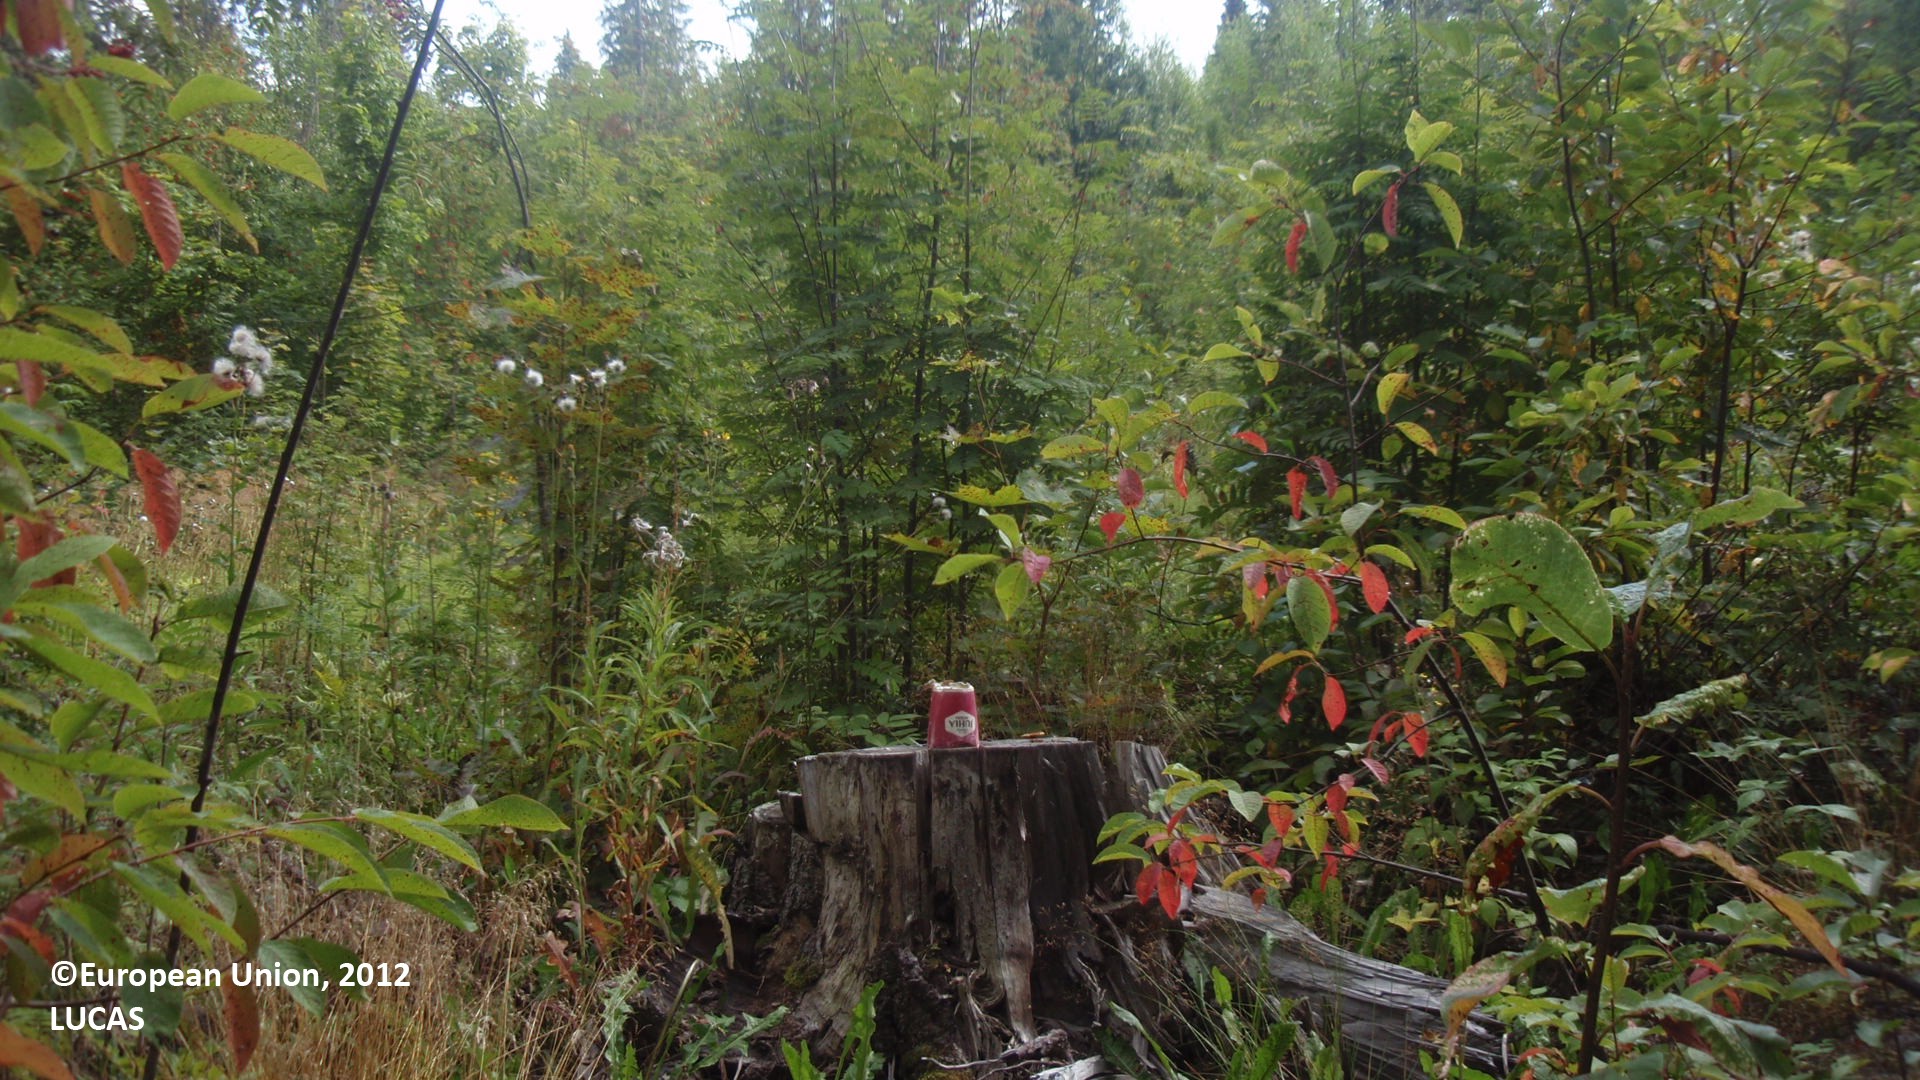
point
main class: Woodland
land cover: Broadleaved woodland
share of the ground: > 75 %
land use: Forestry
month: August
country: FI
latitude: 60.8843
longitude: 26.6085
